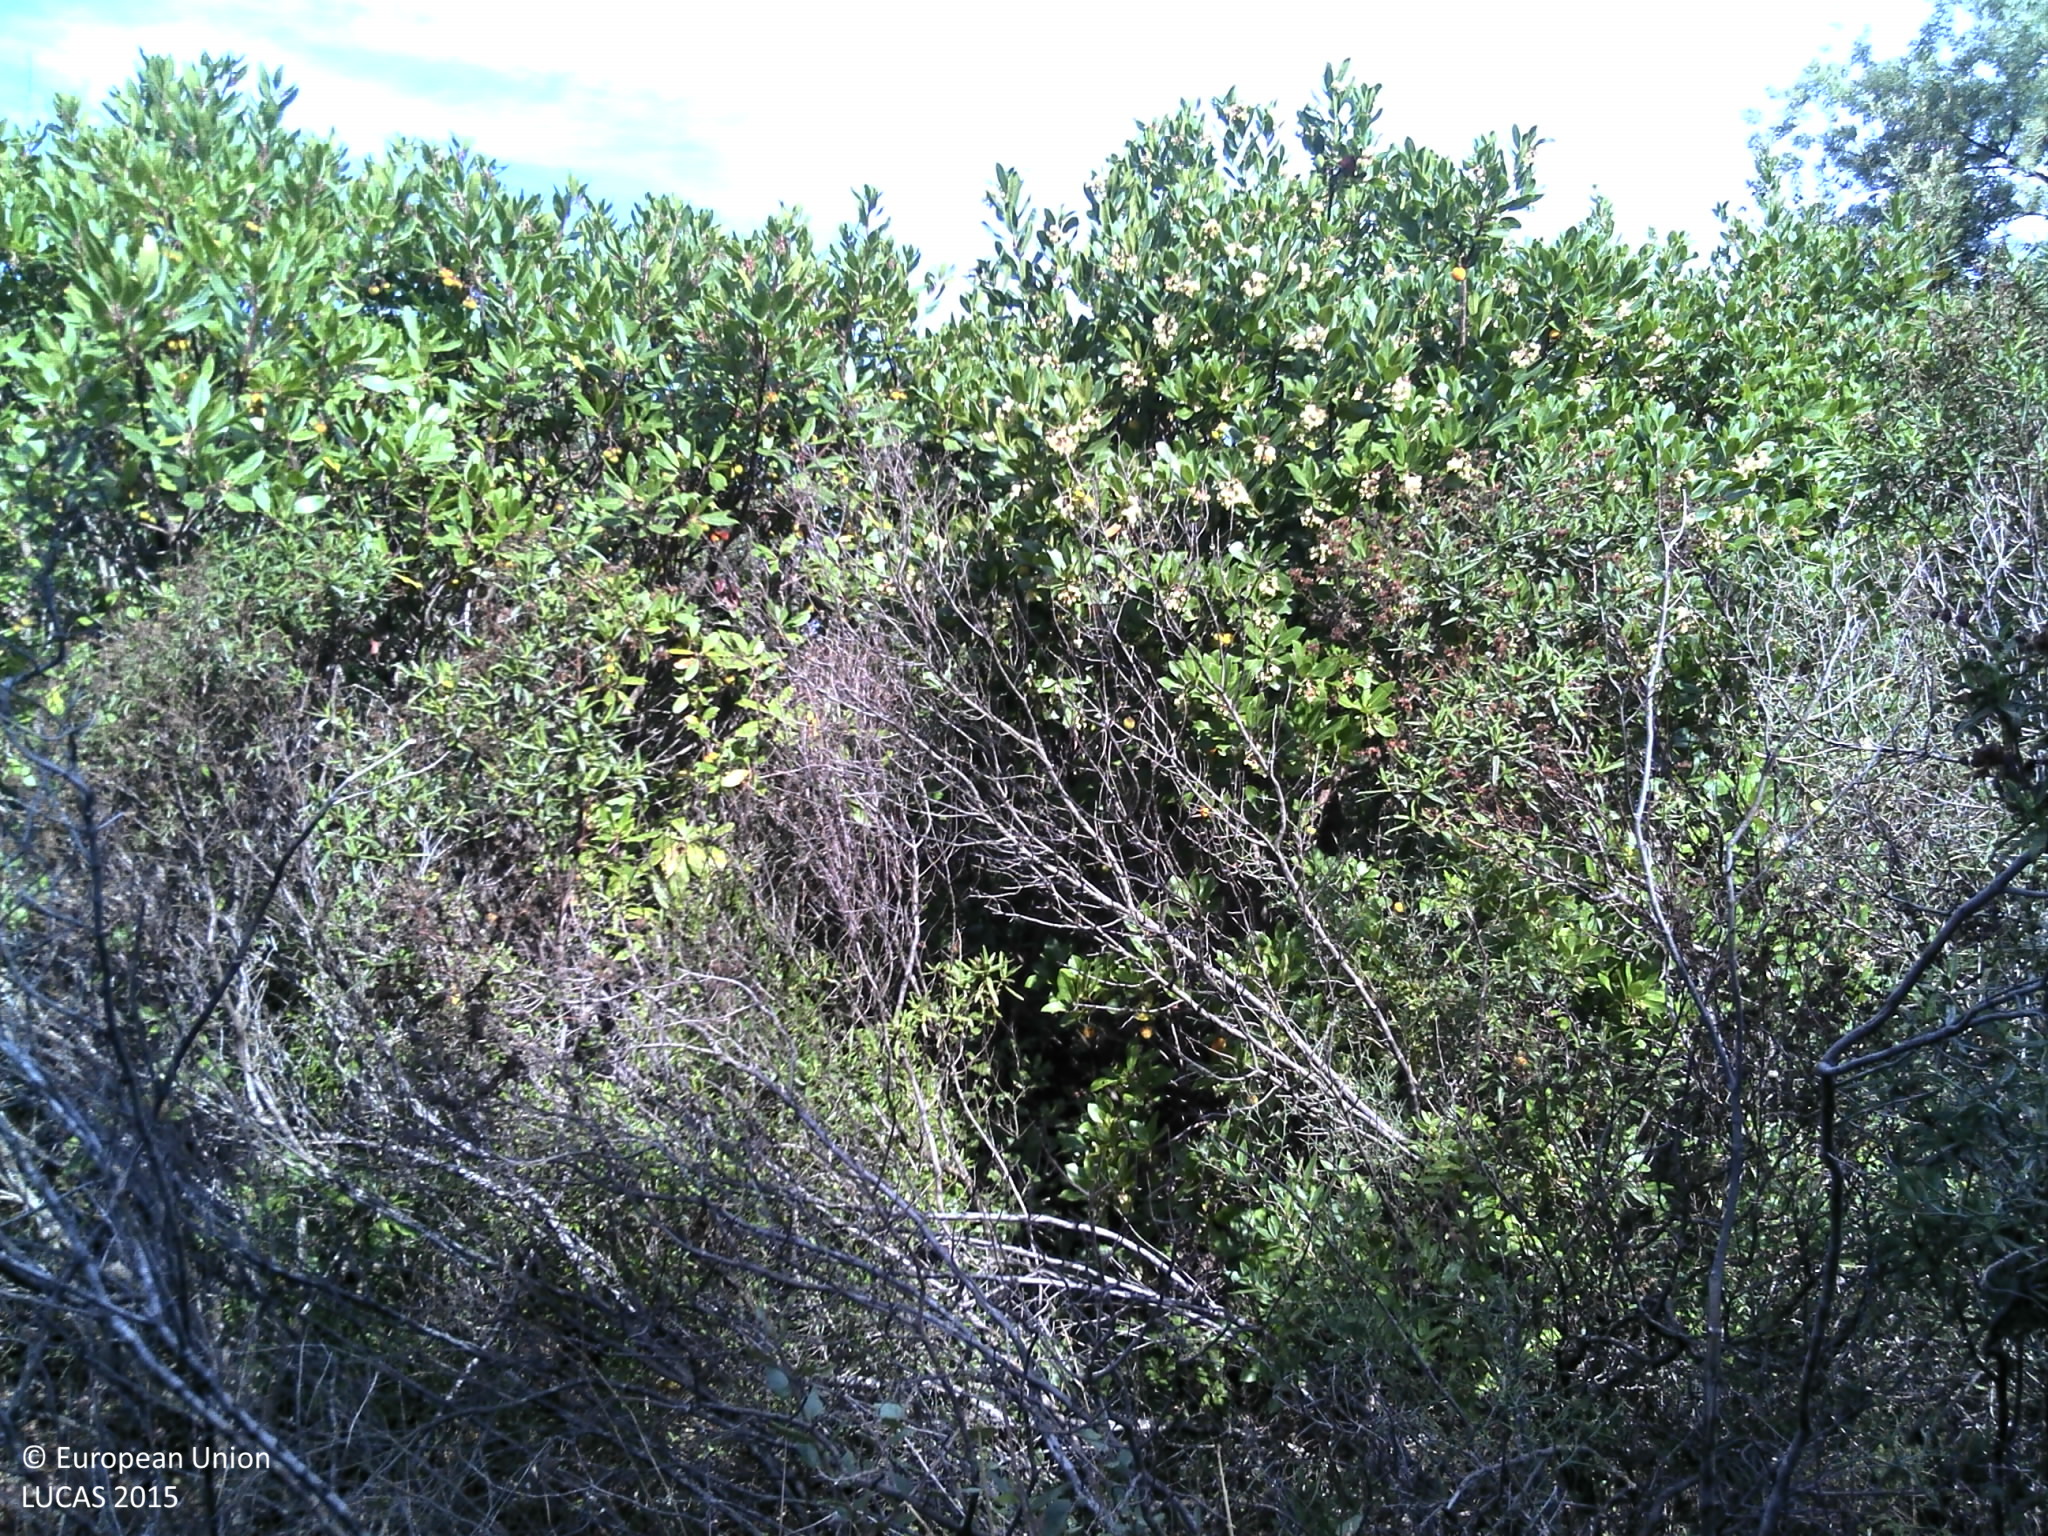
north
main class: Woodland
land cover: Broadleaved woodland
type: broadleaved evergreen forest
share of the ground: > 75 %
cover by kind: broadleaved forest trees 80 %, shrubs 20 %
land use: Semi-natural and natural areas not in use
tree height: > 5 m
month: October
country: FR
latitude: 43.1925
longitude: 6.5759
